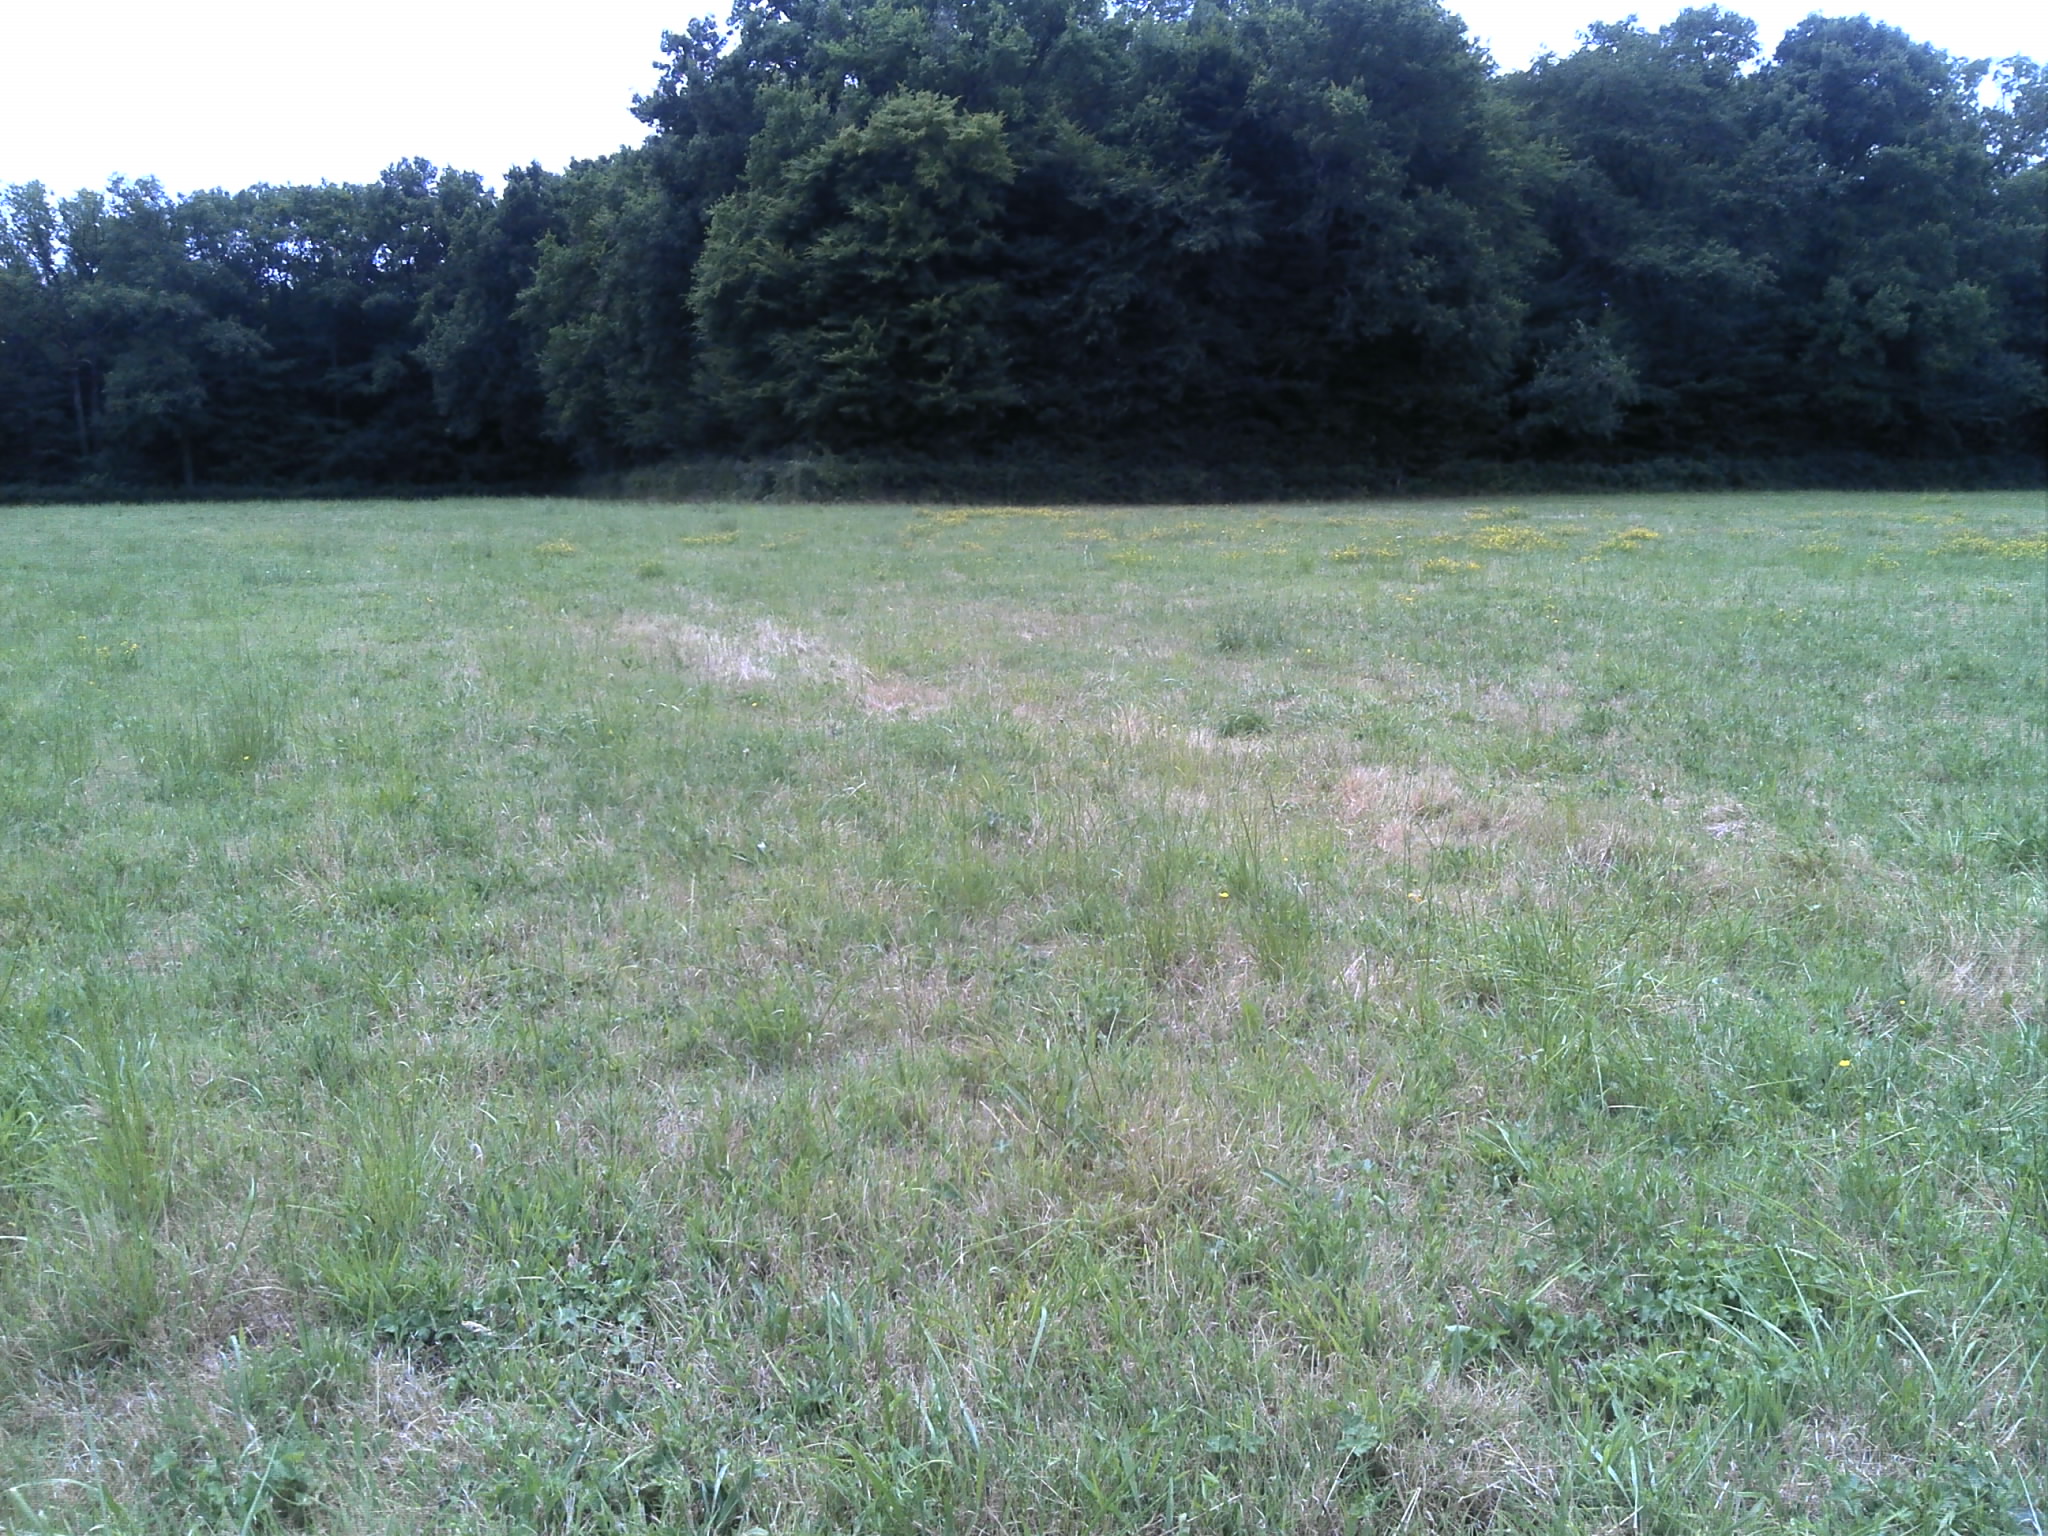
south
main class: Grassland
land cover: Grassland without tree/shrub cover
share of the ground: > 75 %
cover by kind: herbaceous plants 100 %
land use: Agriculture (excluding fallow land and kitchen gardens)
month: July
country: FR
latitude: 46.7184
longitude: 1.4982
